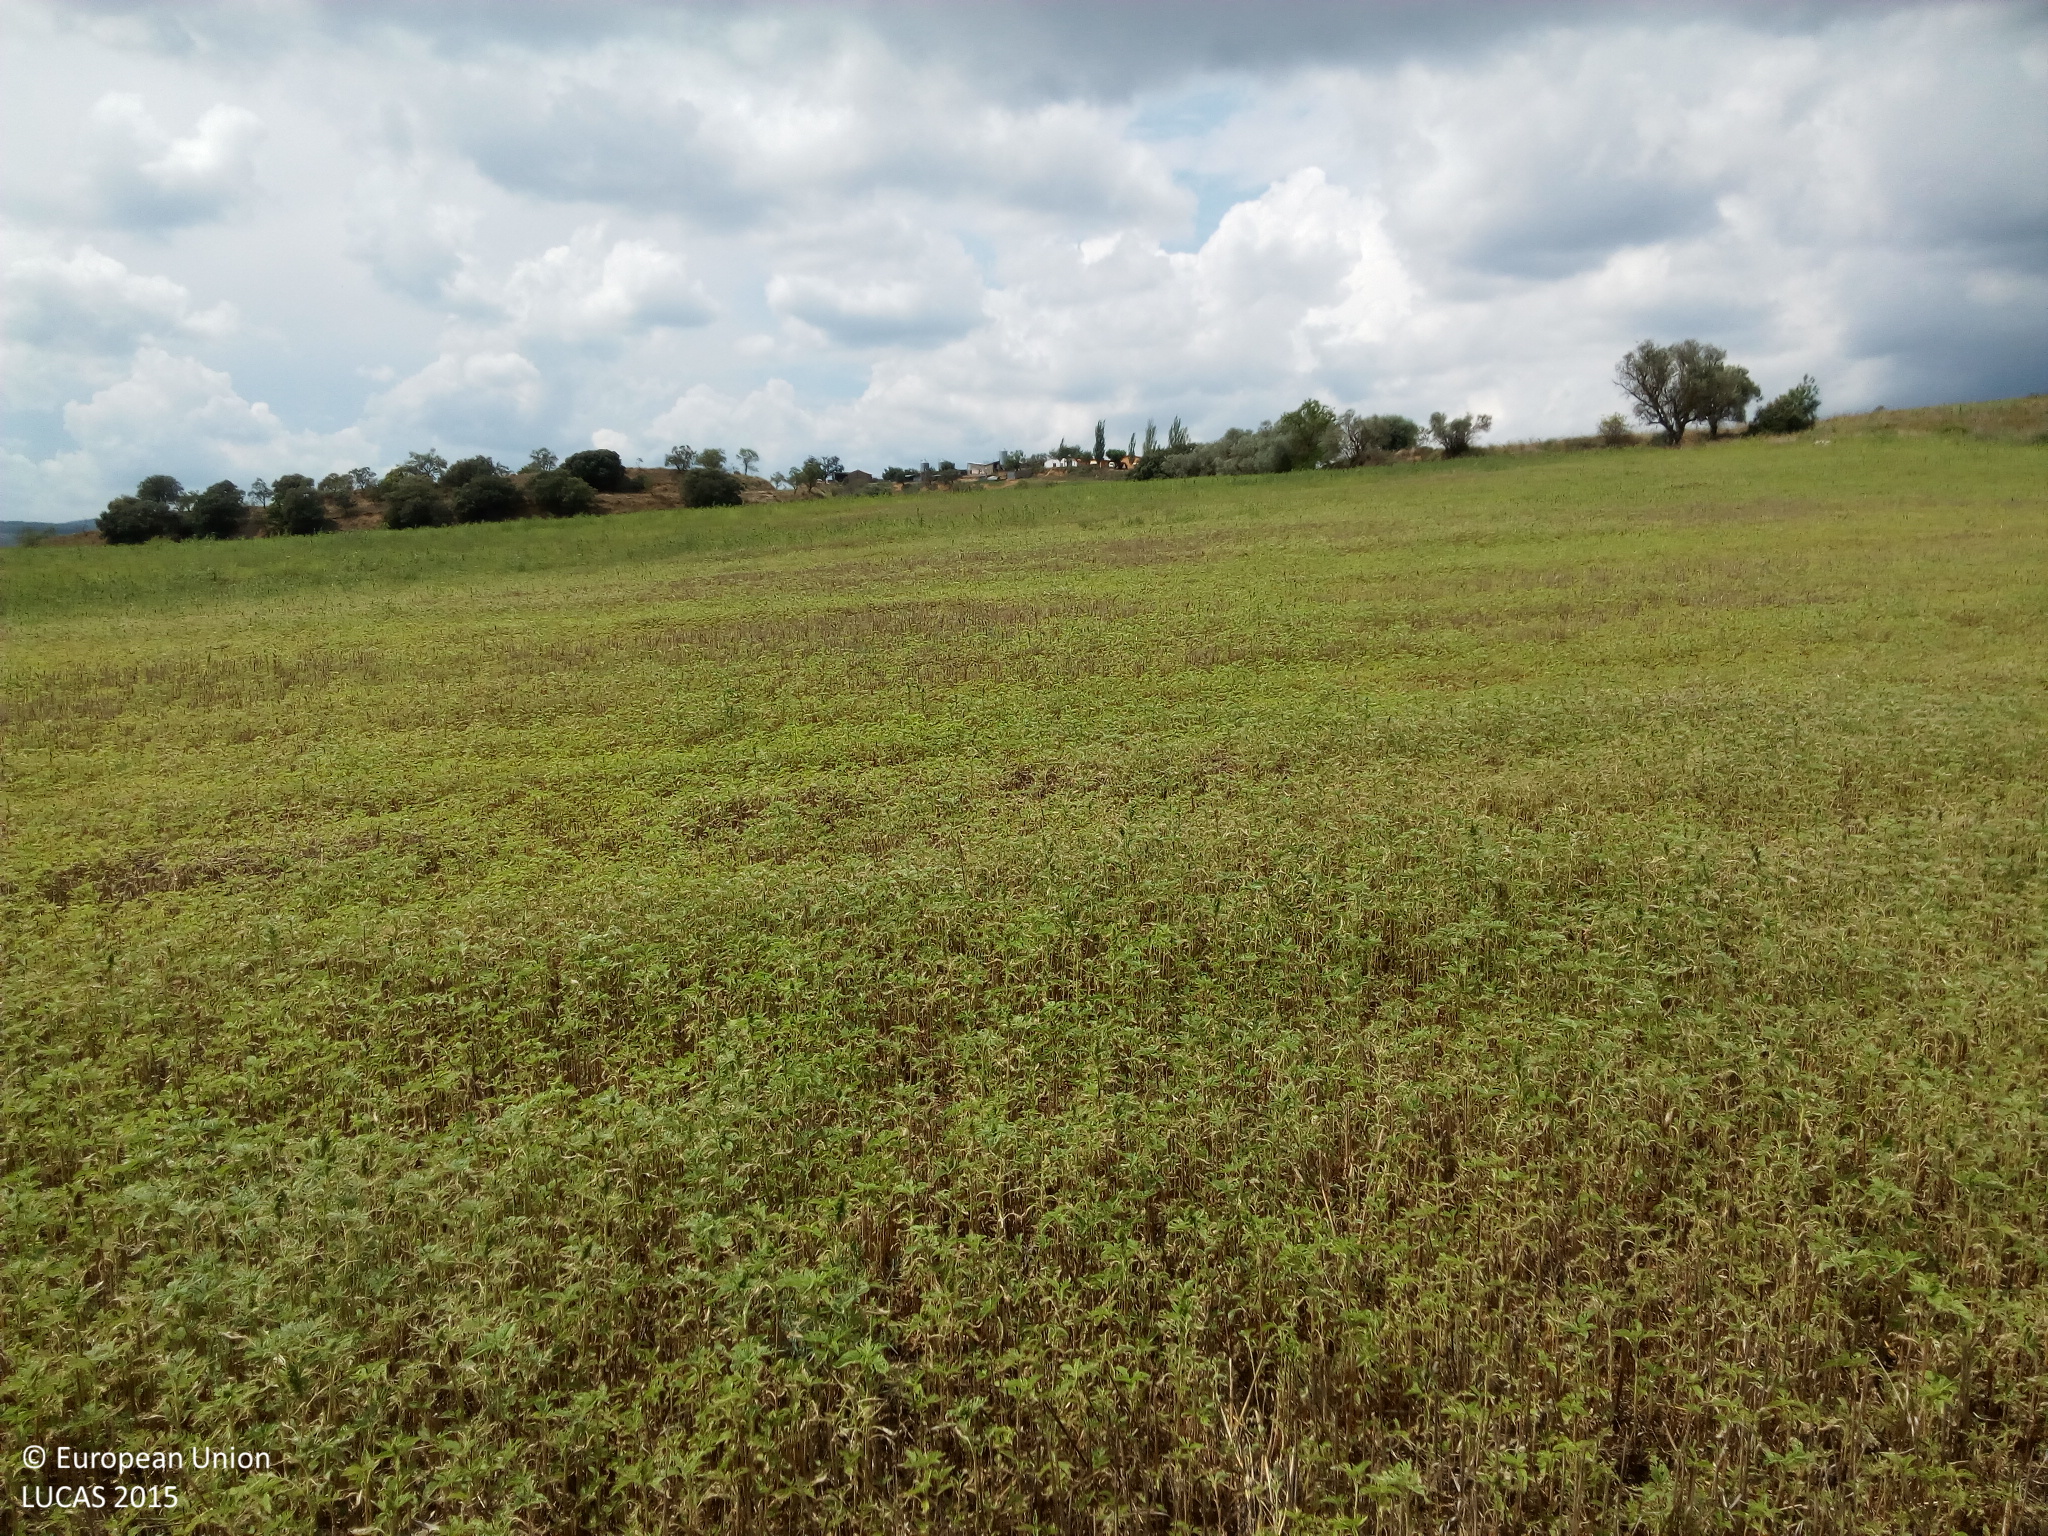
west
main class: Grassland
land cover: Spontaneously vegetated surfaces
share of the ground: > 75 %
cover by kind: herbaceous plants 100 %
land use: Fallow land
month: August
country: ES
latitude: 42.0990
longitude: 0.5157
